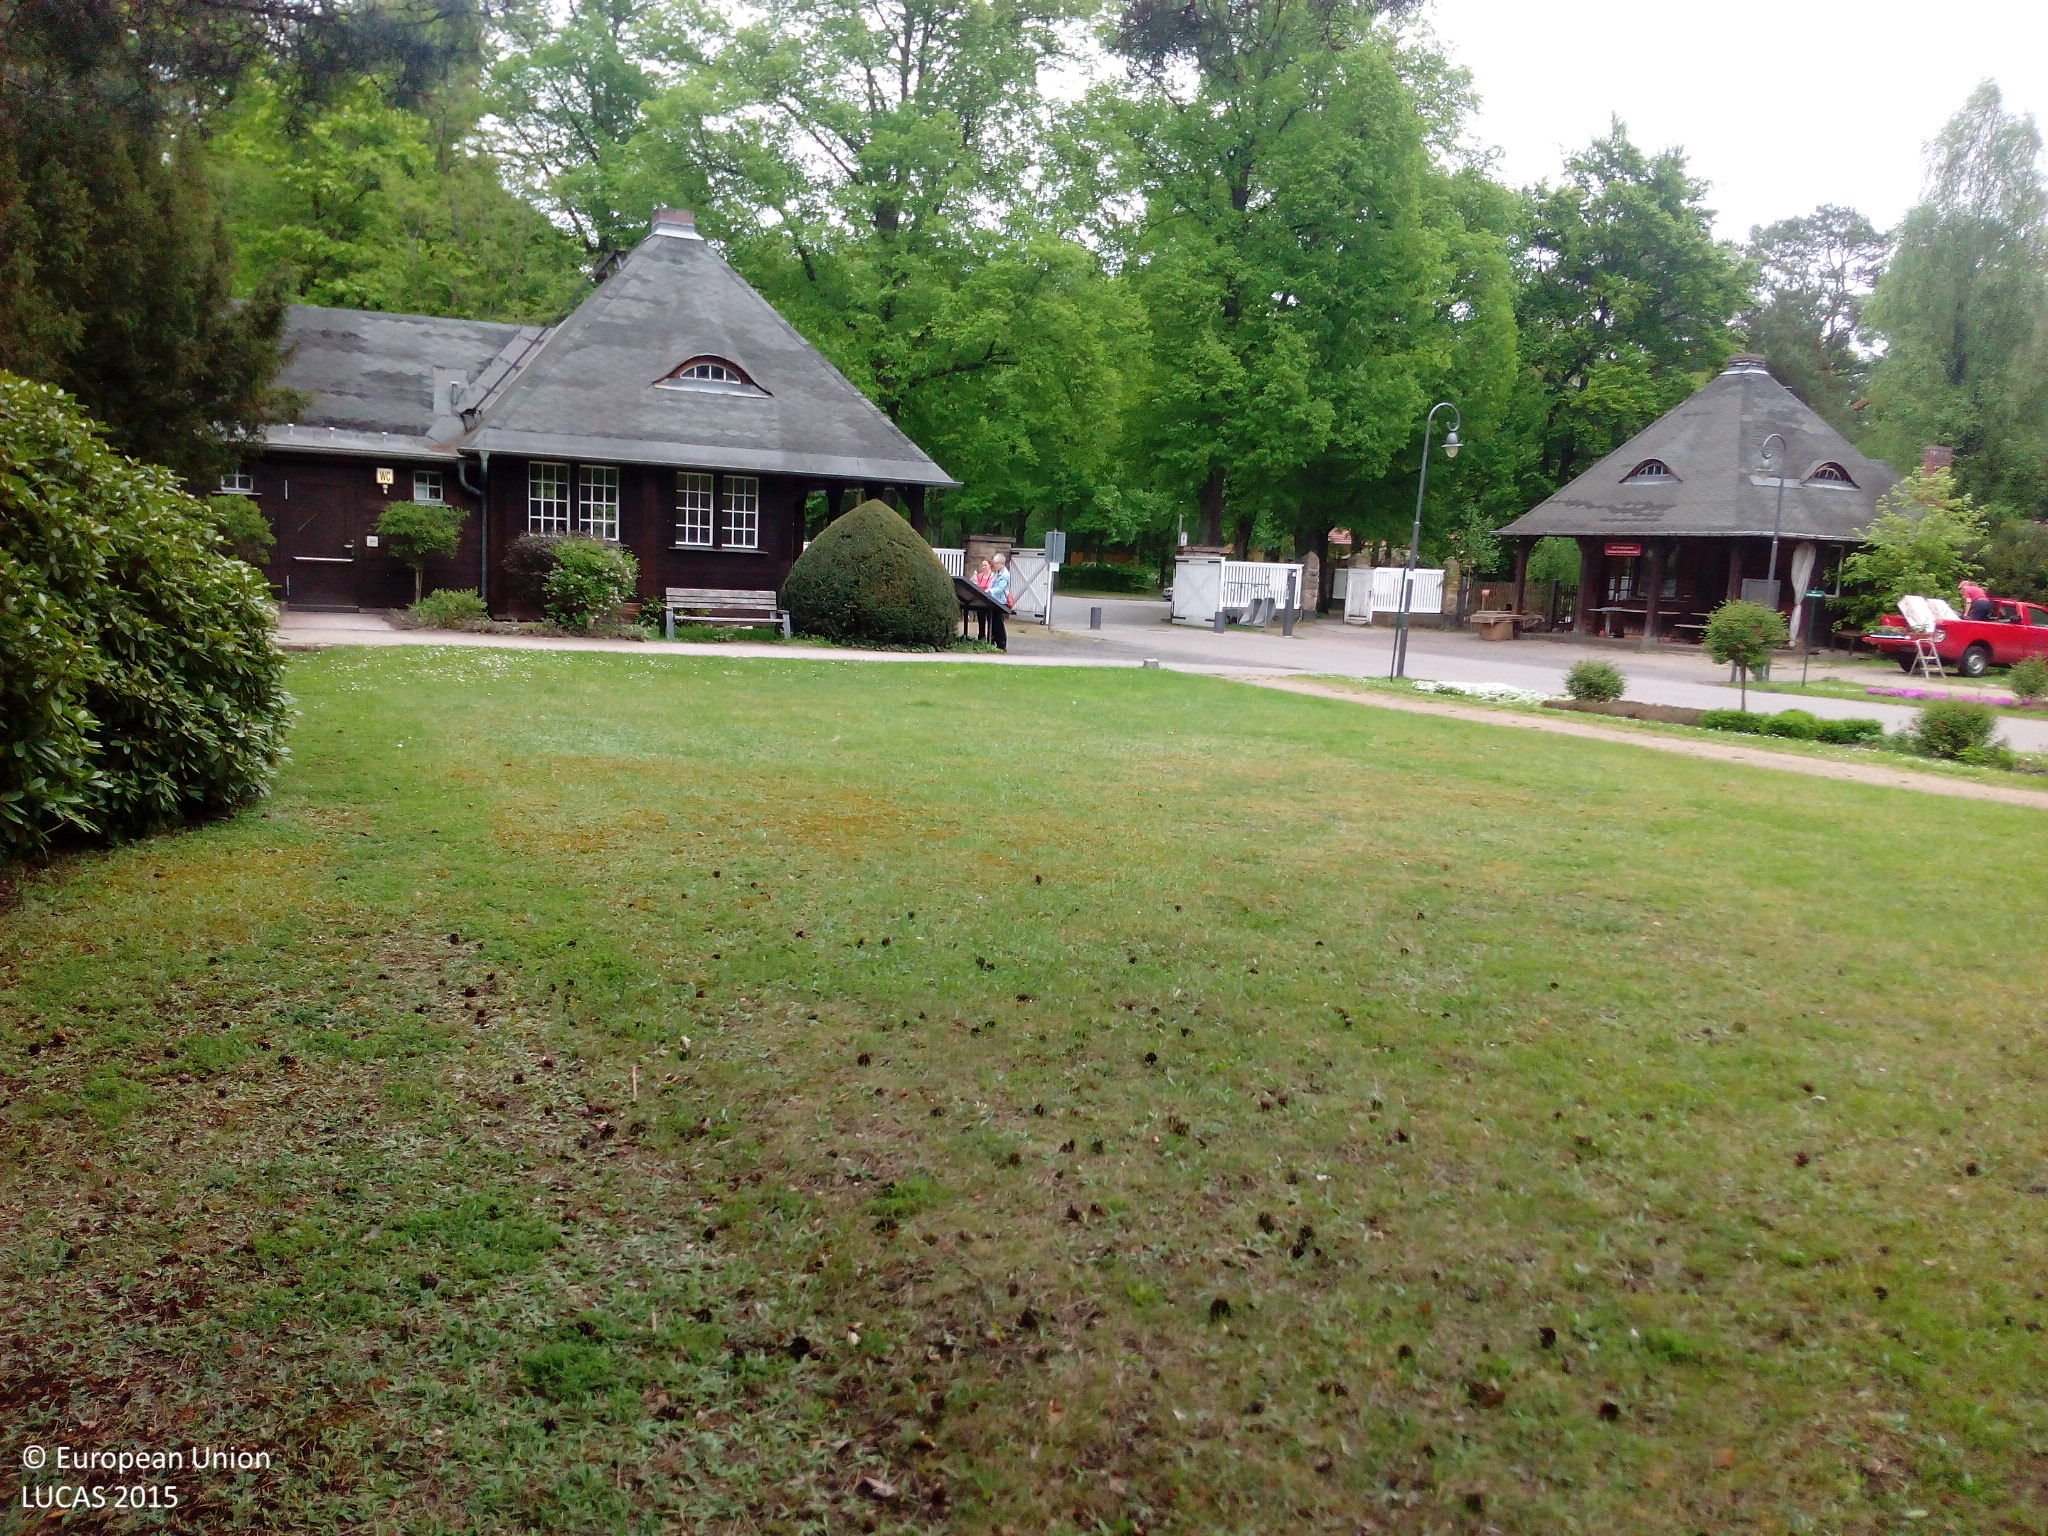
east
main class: Woodland
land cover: Broadleaved woodland
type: mesophytic deciduous forest
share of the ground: 50 - 75 %
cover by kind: broadleaved forest trees 60 %, shrubs 20 %, herbaceous plants 10 %, consolidated bare surface 10 %
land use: Community services
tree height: > 5 m
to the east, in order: Broadleaved woodland; Artificial constructions in urban areas; Paved roads, cycling and walking lanes; Broadleaved woodland; Tracks; Grassland without tree/shrub cover; Single bushes/trees; Artificial constructions in urban areas
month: May
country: DE
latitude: 52.3887
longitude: 13.1885
